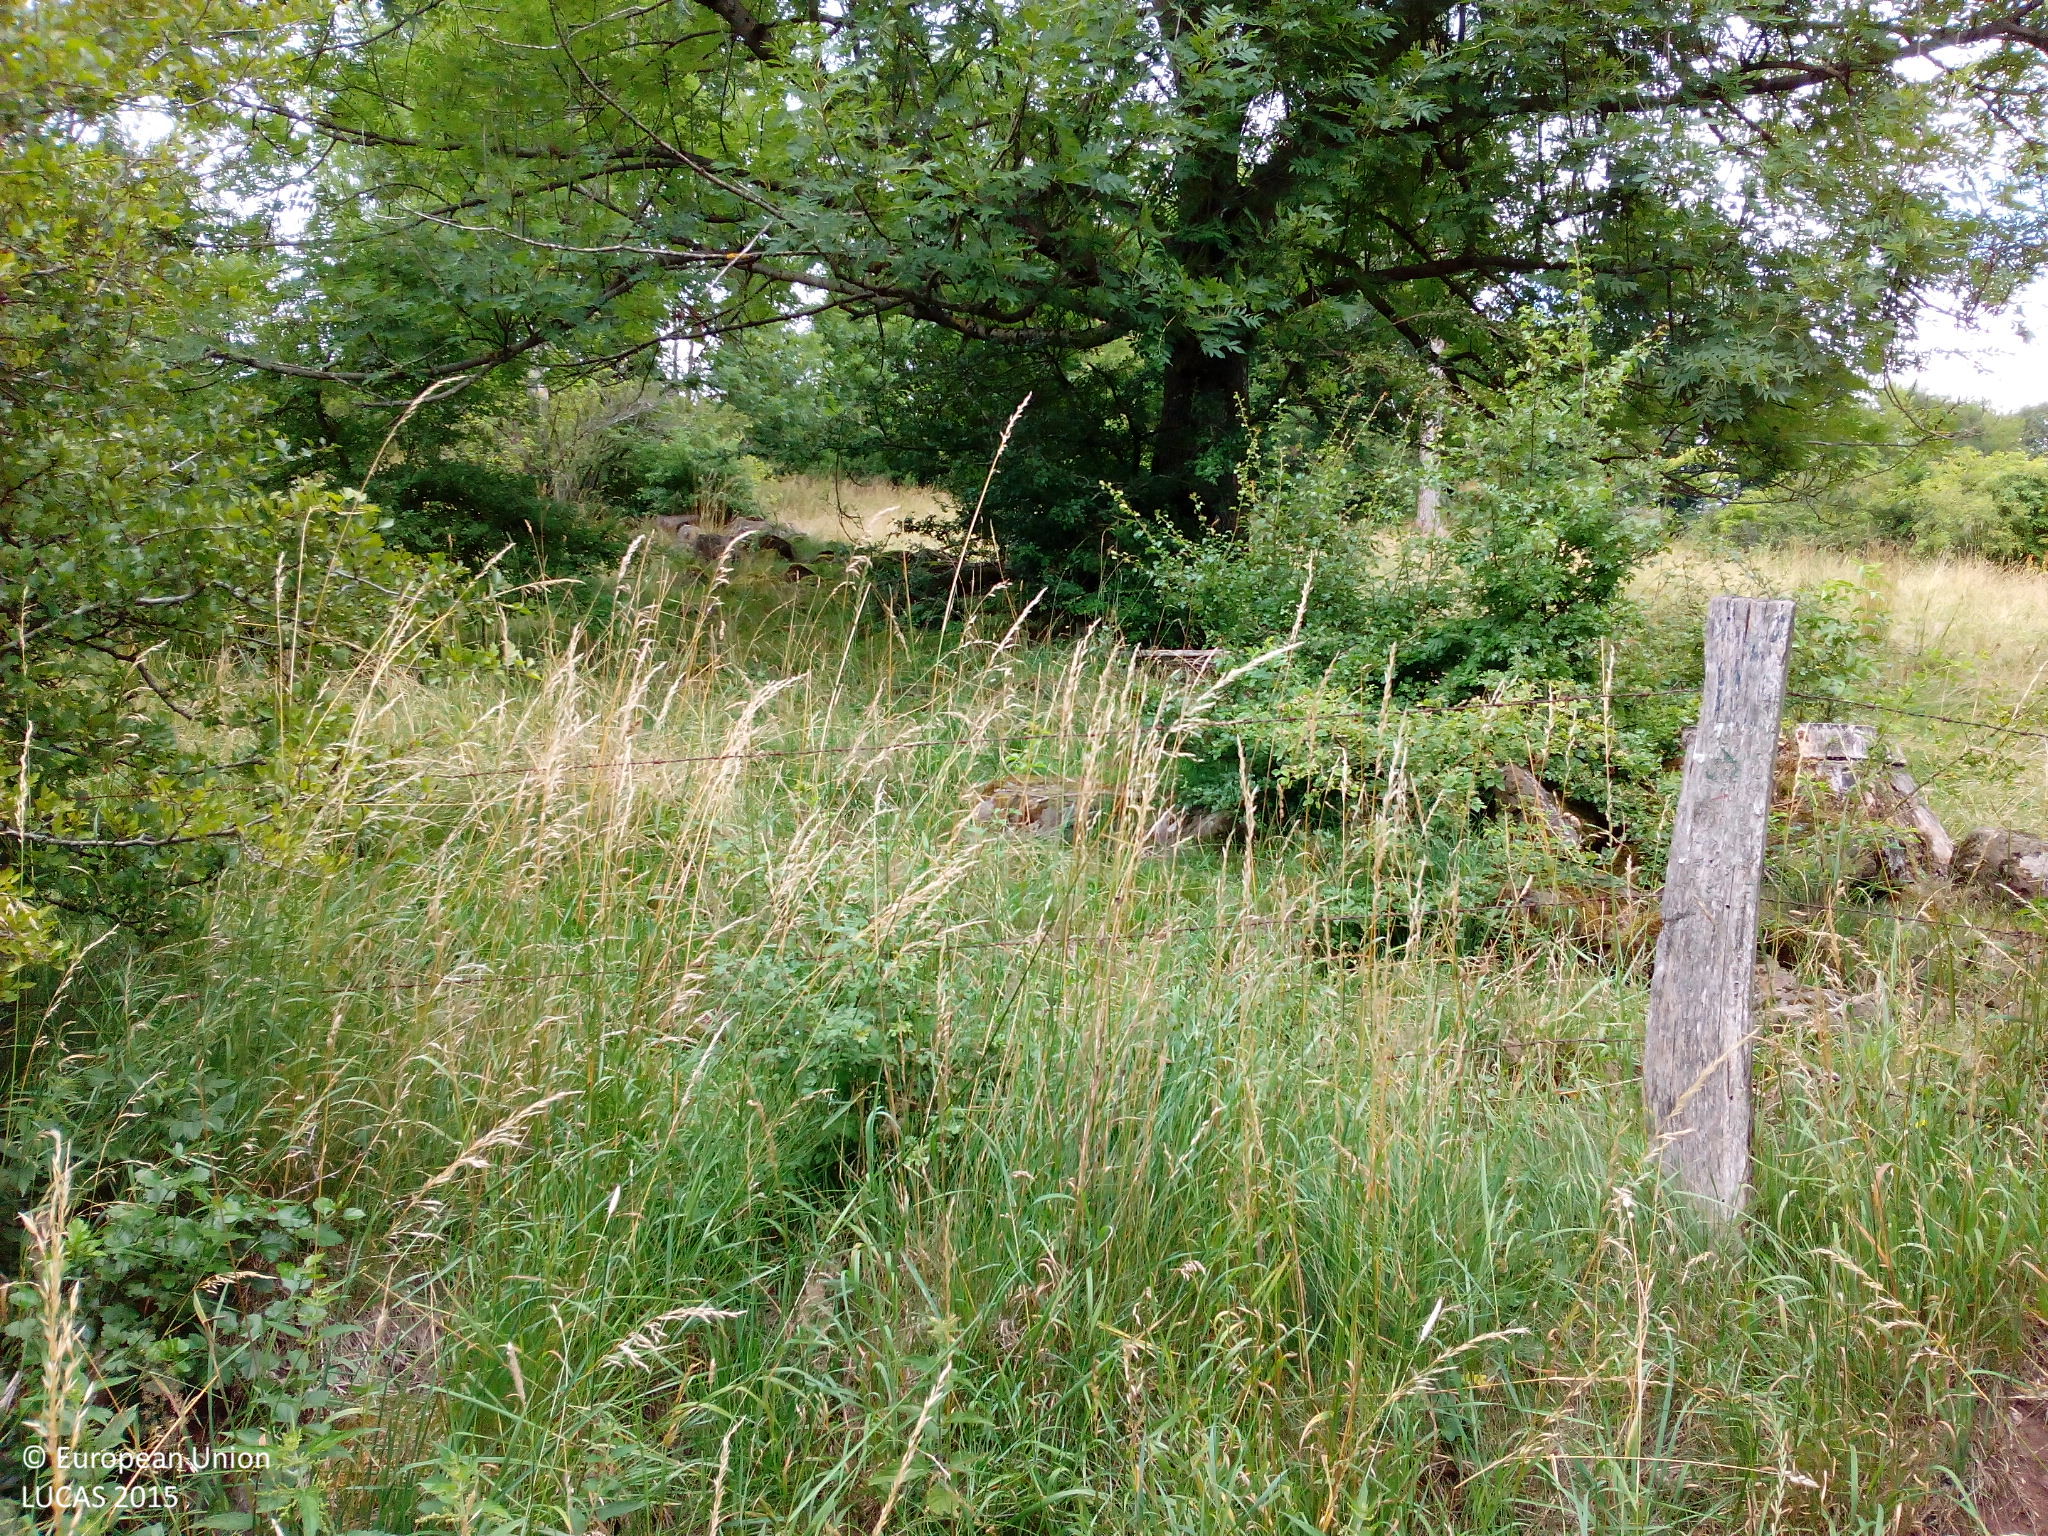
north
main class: Woodland
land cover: Broadleaved woodland
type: thermophilous deciduous forest
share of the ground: > 75 %
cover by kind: broadleaved forest trees 75 %, herbaceous plants 15 %, shrubs 10 %
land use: Agriculture (excluding fallow land and kitchen gardens)
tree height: > 5 m
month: July
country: DE
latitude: 50.4719
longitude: 9.9296
